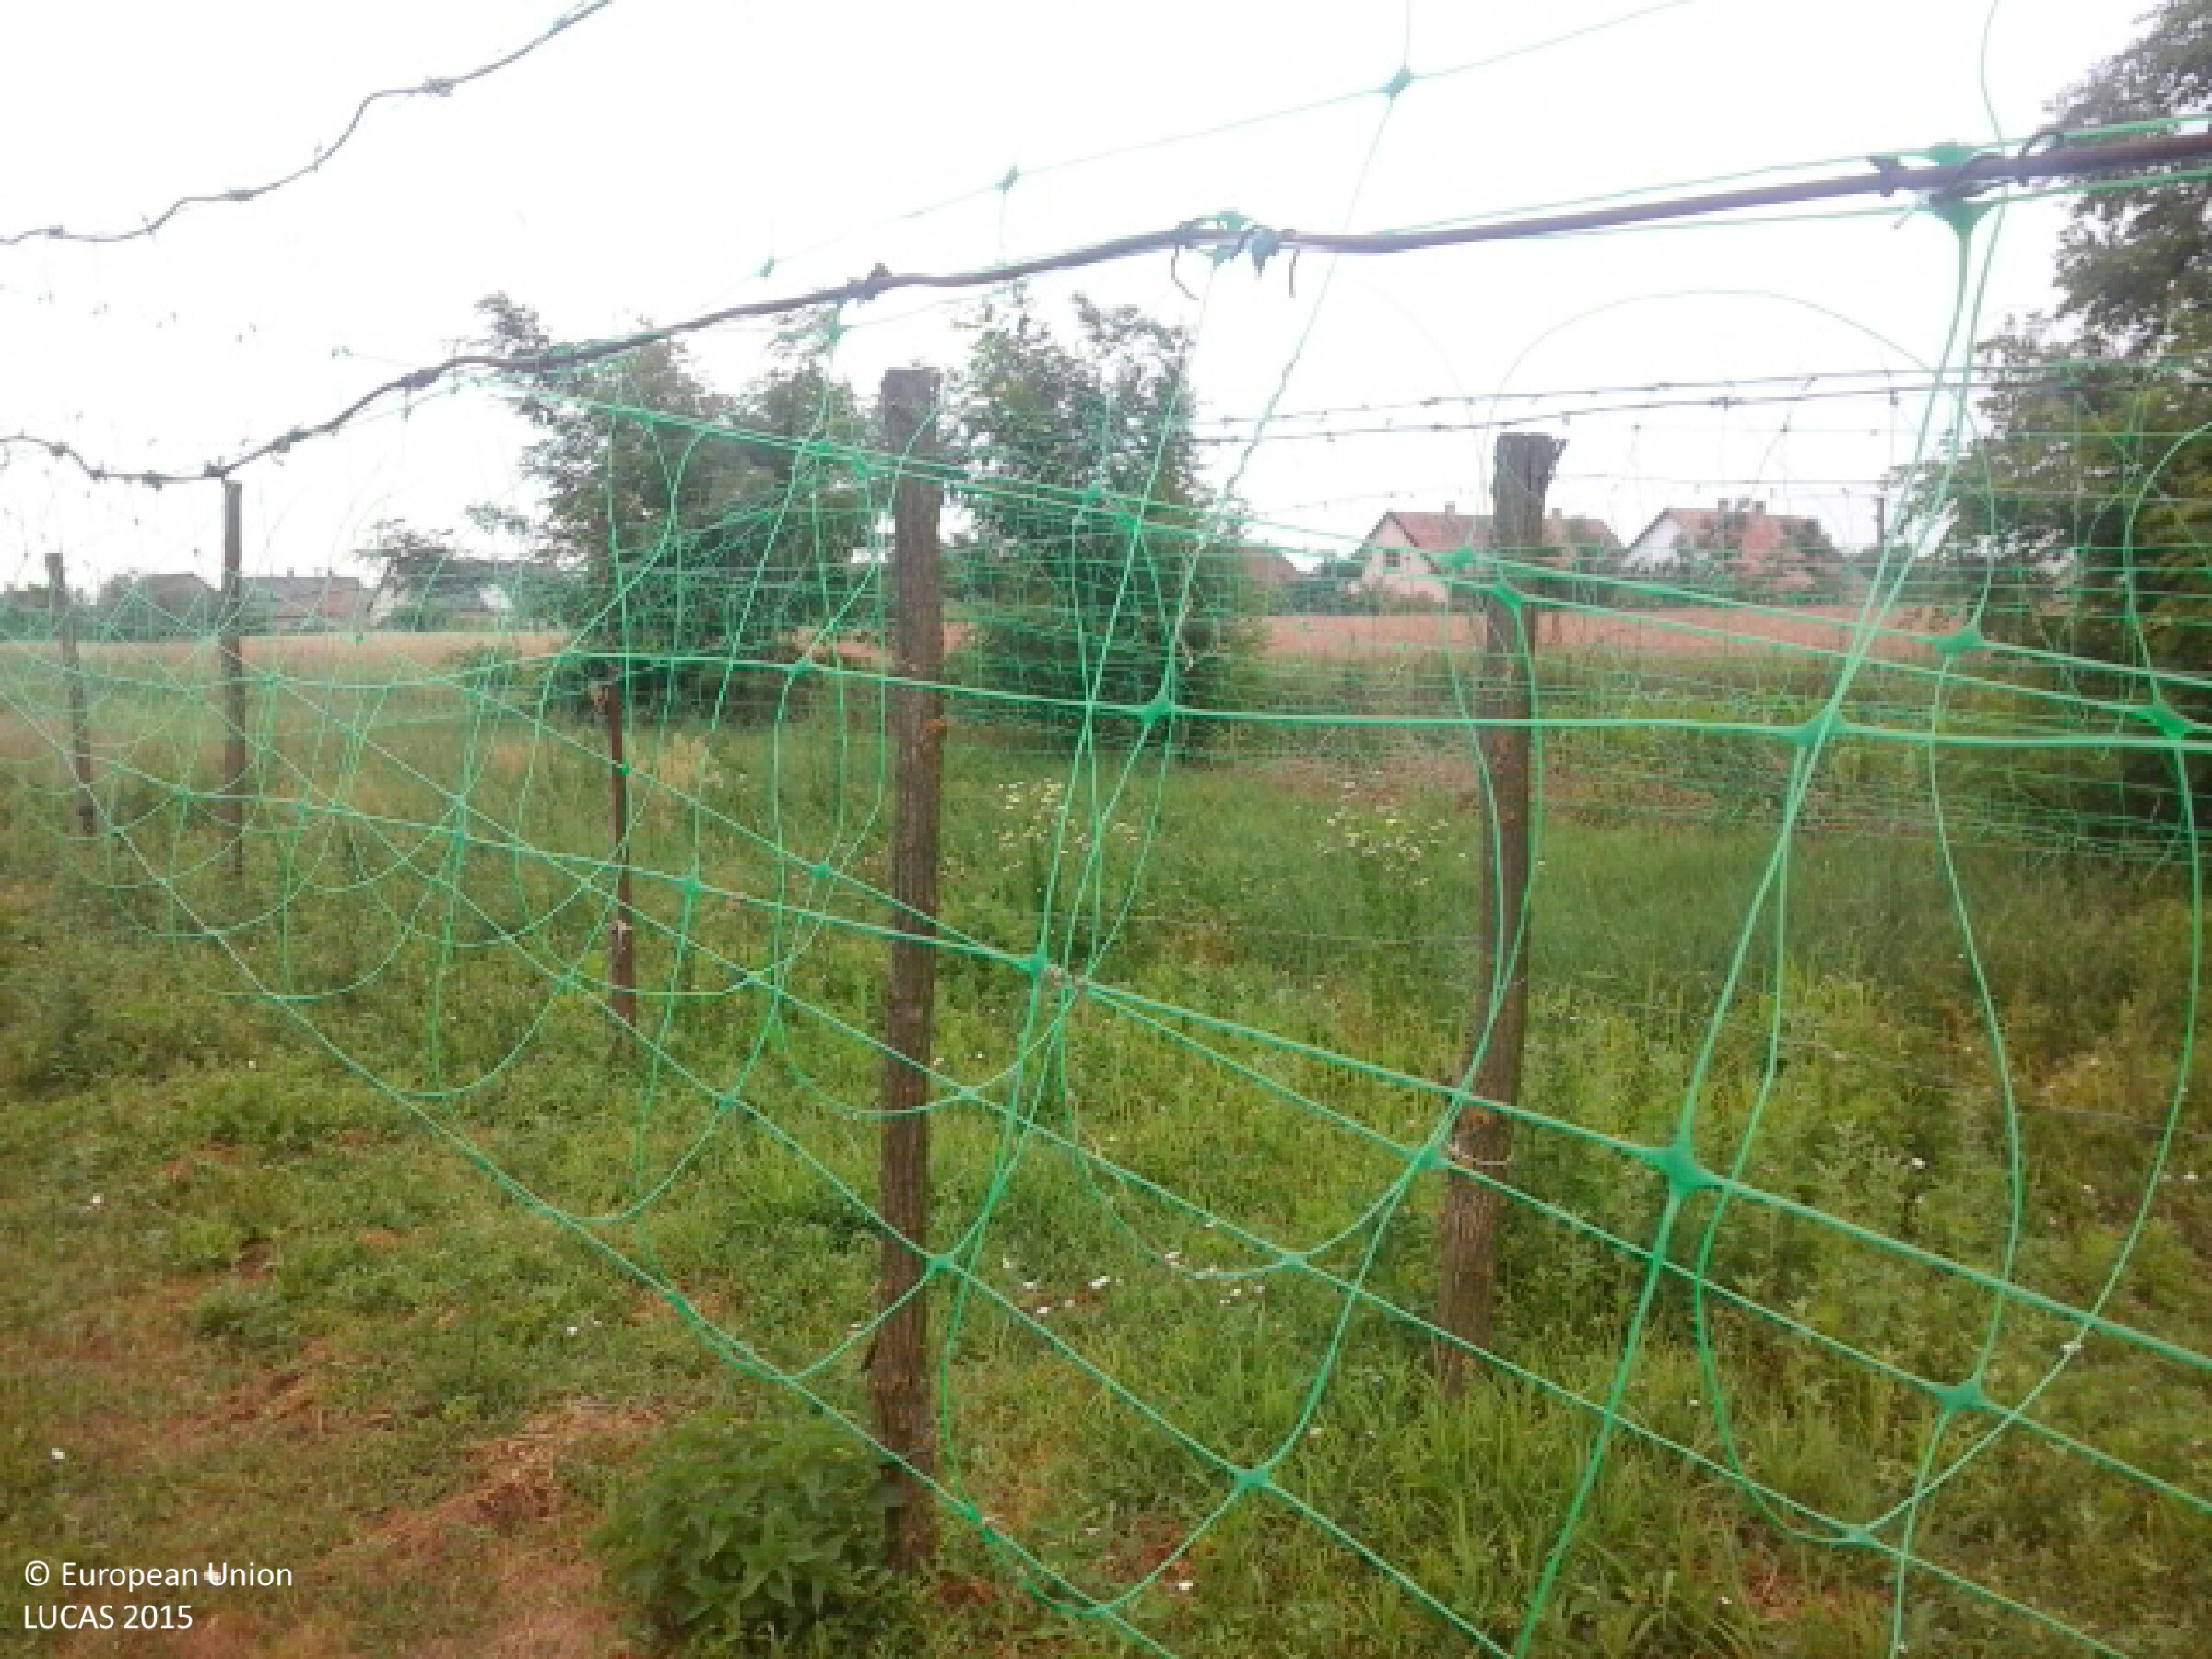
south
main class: Grassland
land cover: Spontaneously vegetated surfaces
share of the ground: > 75 %
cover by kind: herbaceous plants 100 %
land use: Fallow land
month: June
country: HU
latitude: 47.9820
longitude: 22.1797
